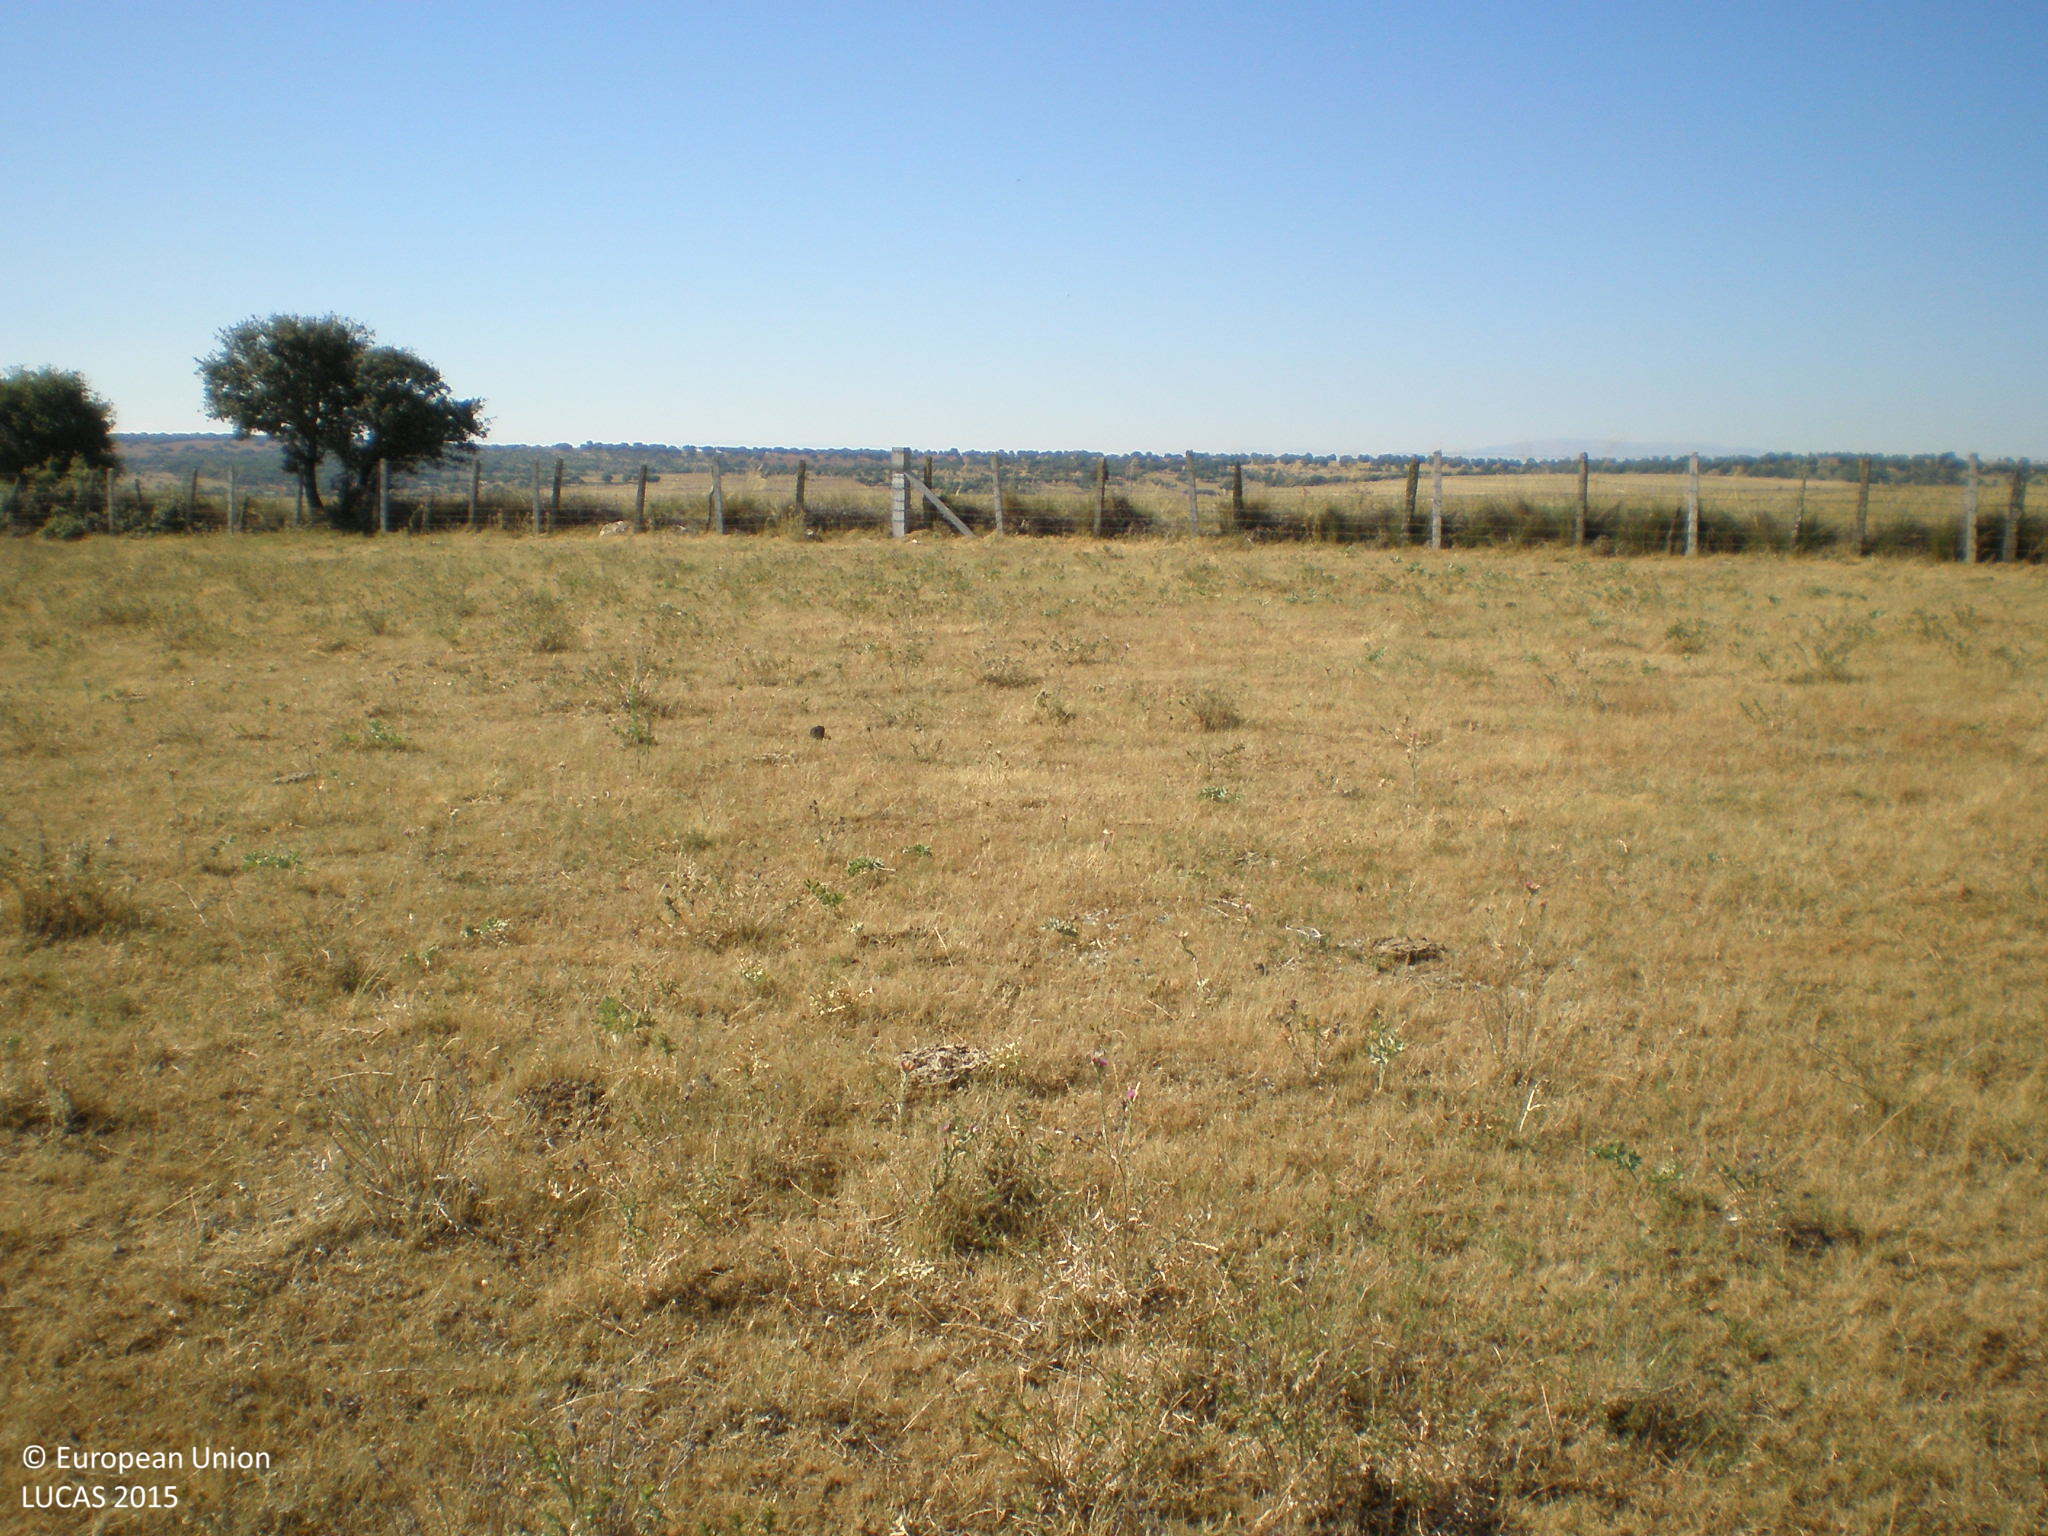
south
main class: Grassland
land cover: Grassland without tree/shrub cover
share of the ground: > 75 %
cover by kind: herbaceous plants 100 %
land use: Agriculture (excluding fallow land and kitchen gardens)
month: June
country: ES
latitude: 40.8125
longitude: -5.7127
